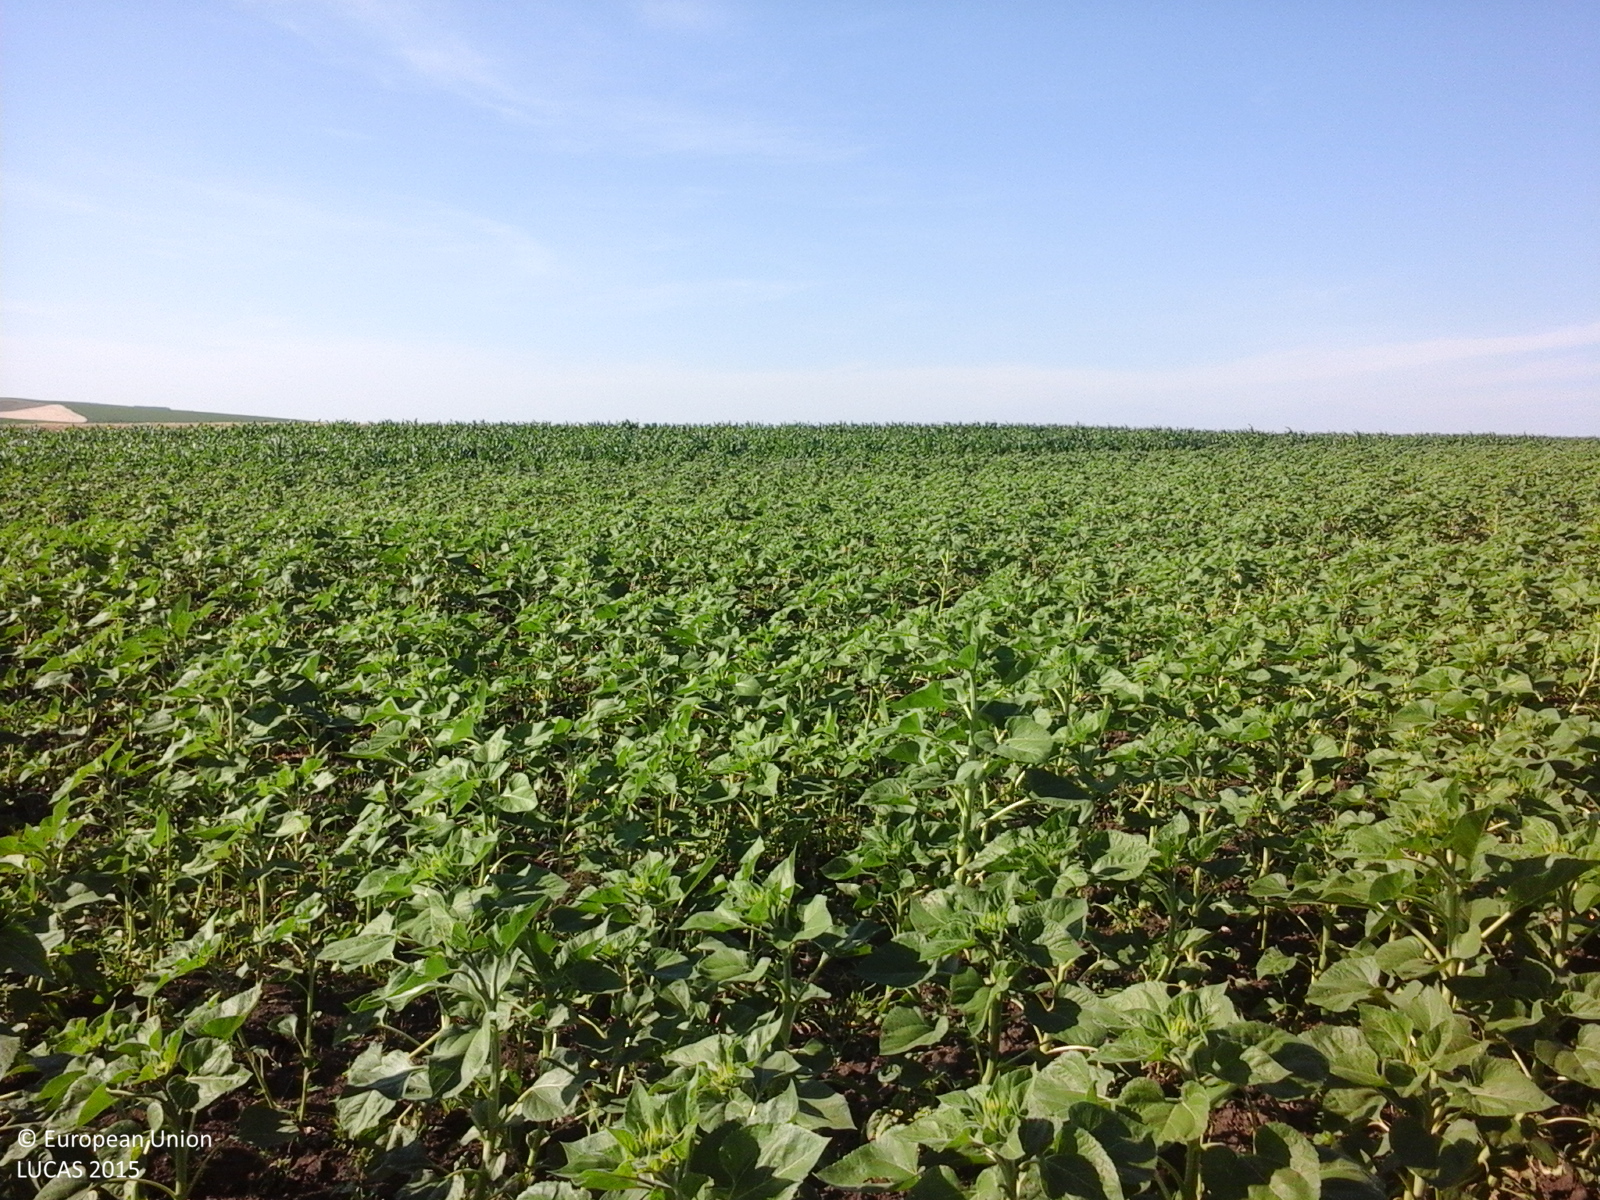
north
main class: Cropland
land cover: Sunflower
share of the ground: 50 - 75 %
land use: Agriculture (excluding fallow land and kitchen gardens)
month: June
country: RO
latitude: 47.4768
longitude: 27.2409
